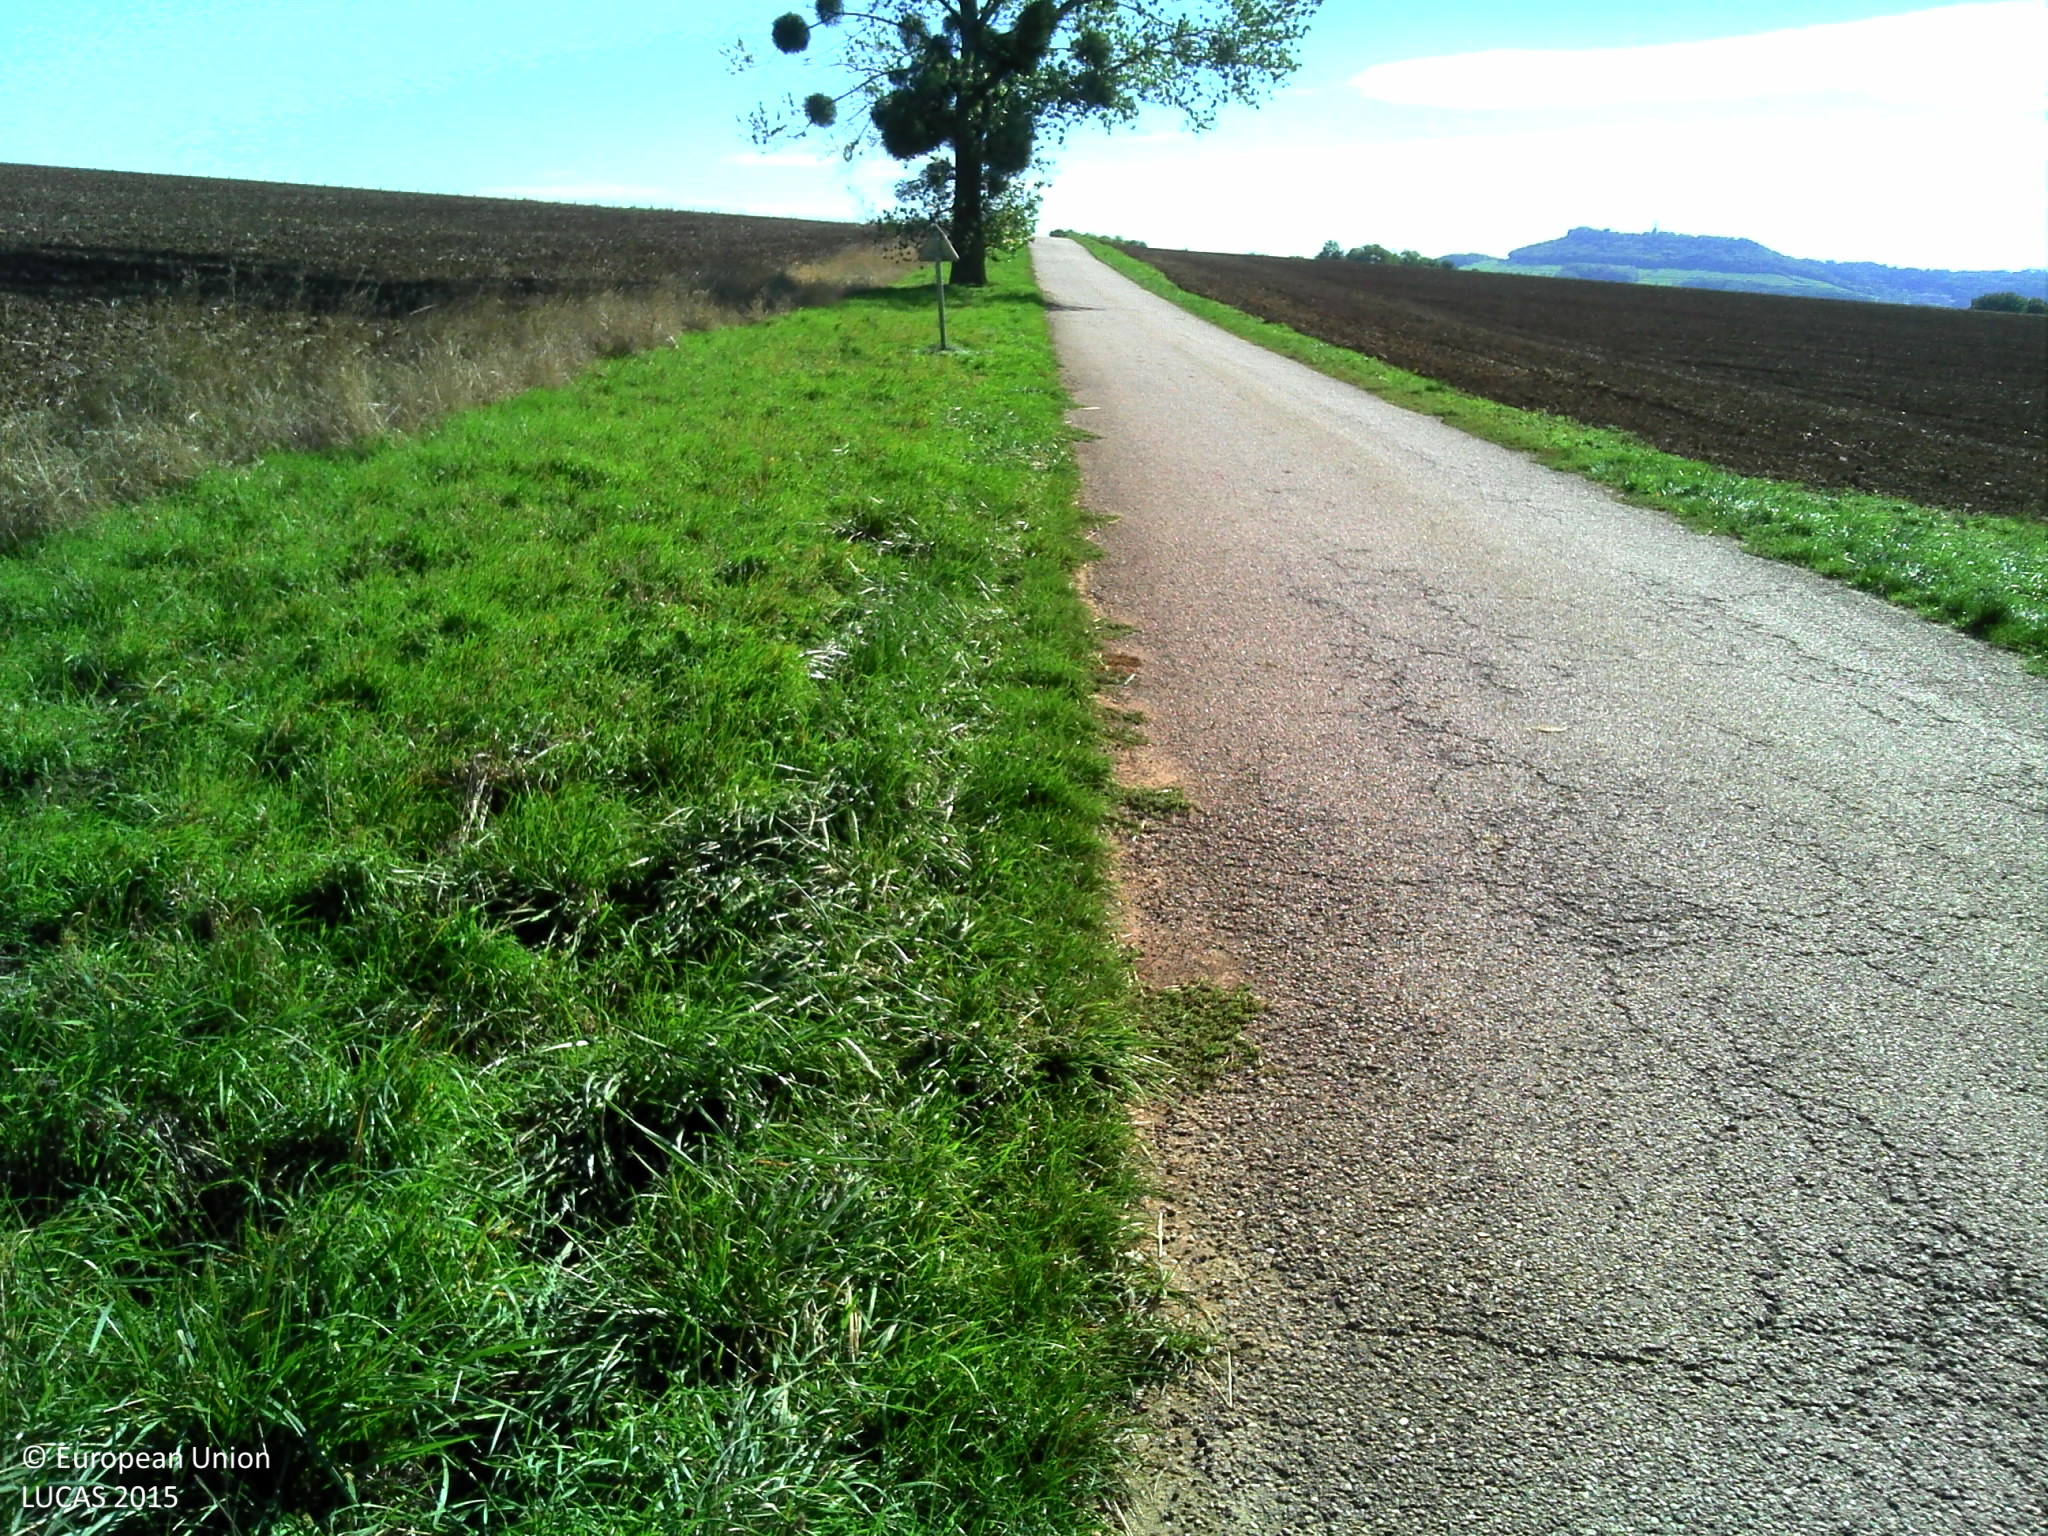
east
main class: Grassland
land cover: Grassland without tree/shrub cover
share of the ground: > 75 %
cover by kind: herbaceous plants 80 %, consolidated bare surface 20 %
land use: Road transport
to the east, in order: Grassland without tree/shrub cover; Ditches and canals; Grass margins; Rape and turnip rape; Other bare soil
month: September
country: FR
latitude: 48.4586
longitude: 6.0379
